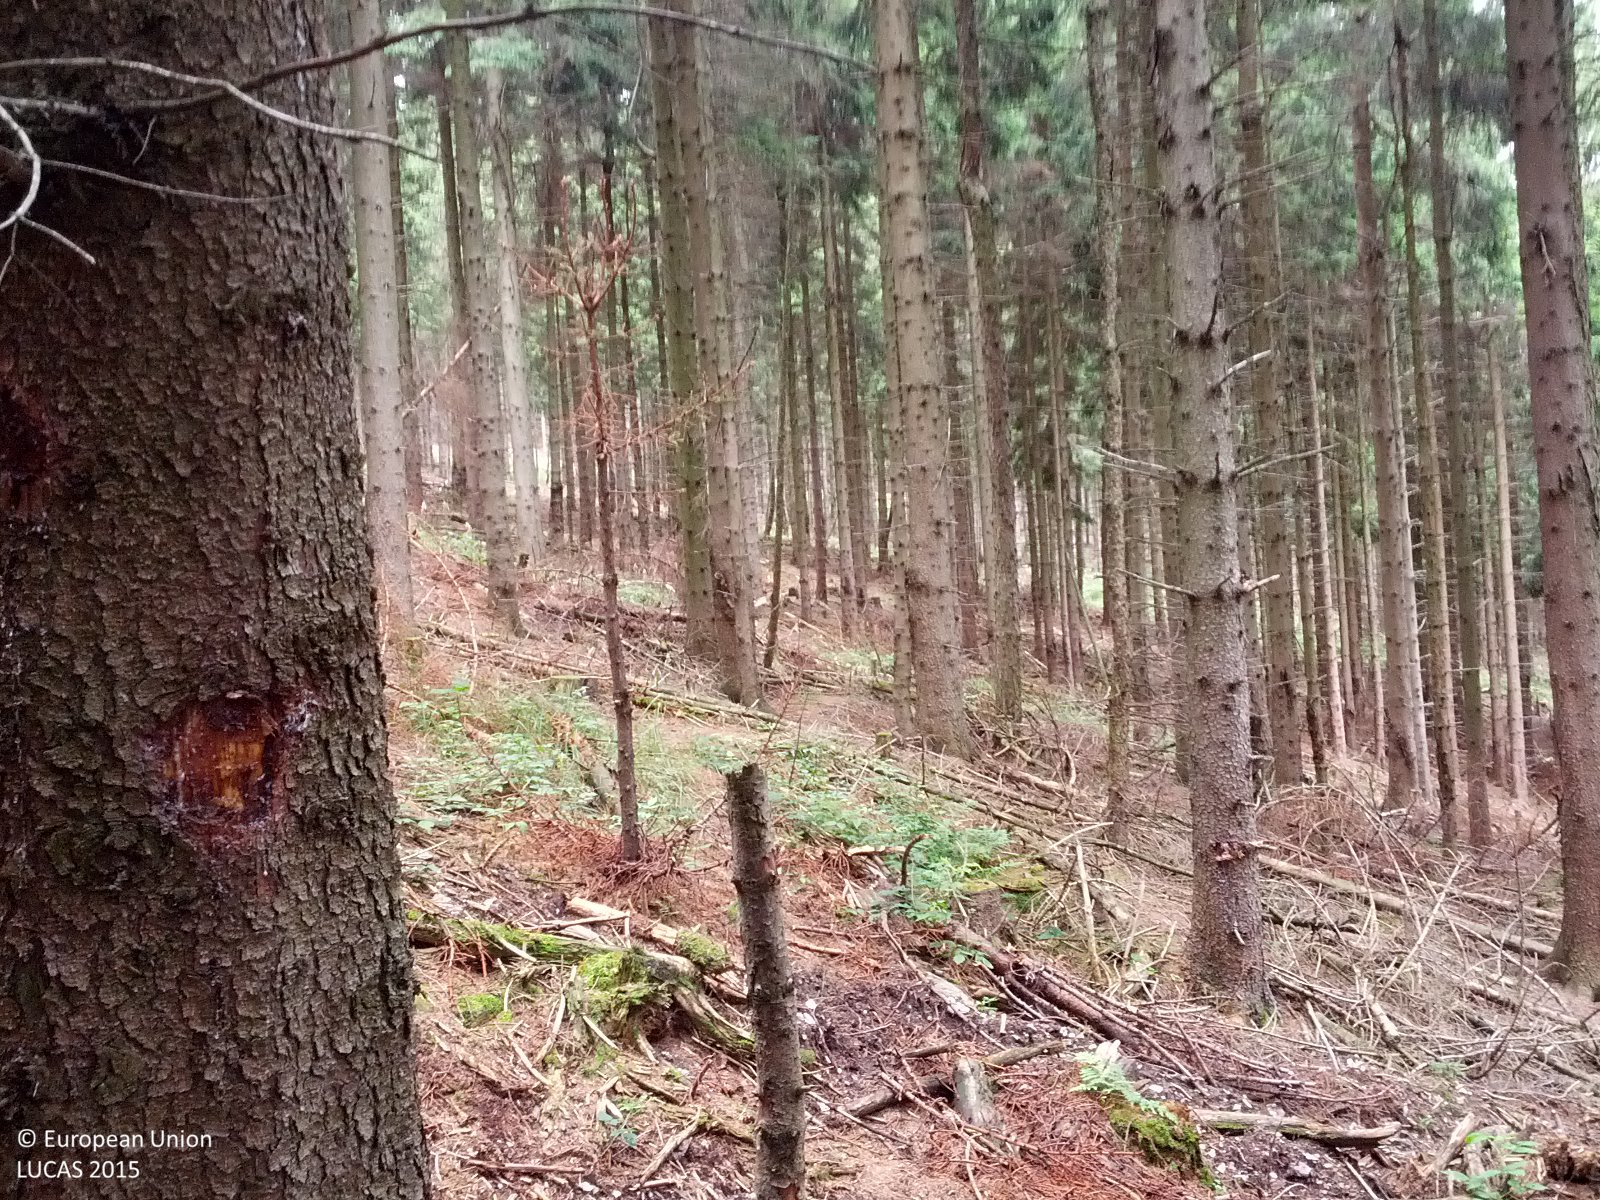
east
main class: Woodland
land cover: Spruce dominated coniferous woodland
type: alpine coniferous forest
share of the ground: > 75 %
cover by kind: coniferous forest trees 90 %, shrubs 5 %, unconsolidated bare surface 5 %
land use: Forestry
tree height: > 5 m
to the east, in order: Spruce dominated coniferous woodland; Grass margins; Tracks; Spruce dominated coniferous woodland; Tracks
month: July
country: AT
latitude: 47.3501
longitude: 16.4234
